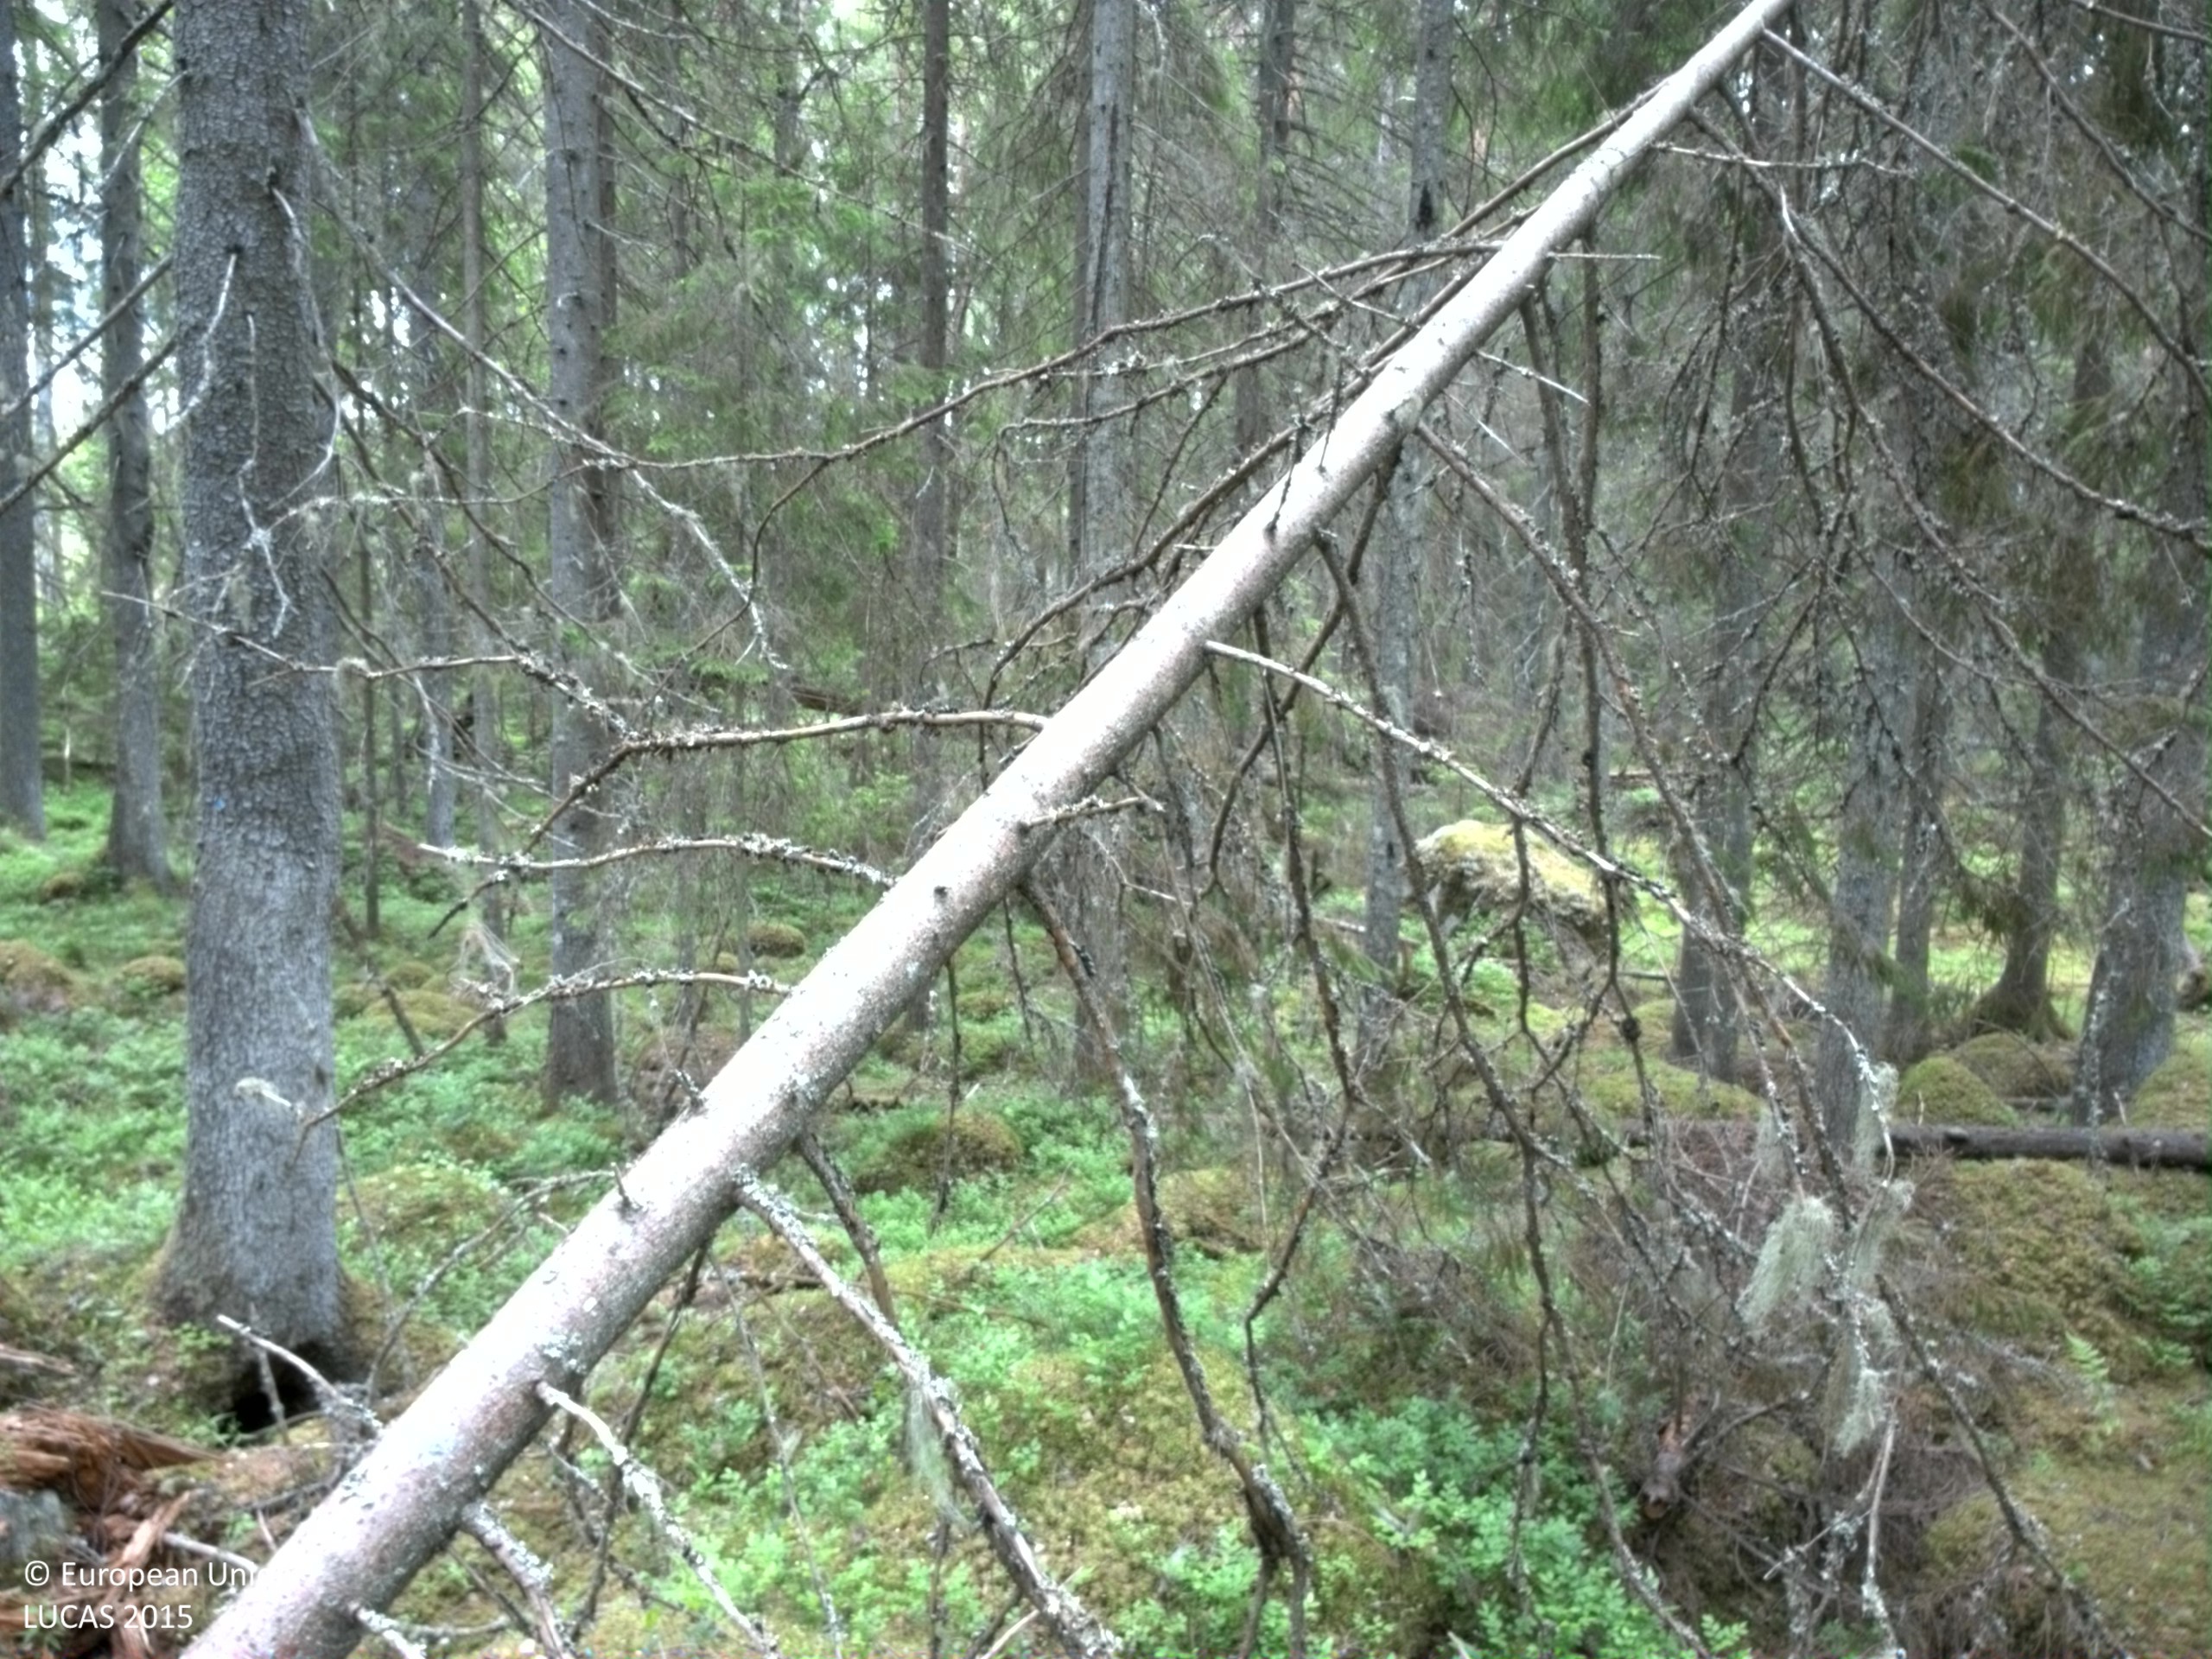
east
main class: Woodland
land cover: Spruce dominated coniferous woodland
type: boreal forest
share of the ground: > 75 %
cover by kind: coniferous forest trees 75 %, shrubs 10 %, lichens and mosses 10 %, broadleaved forest trees 5 %
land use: Forestry
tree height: > 5 m
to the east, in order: Spruce dominated coniferous woodland; Grassland with sparse tree/shrub cover; Other mixed woodland; Spruce dominated mixed woodland
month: June
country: SE
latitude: 60.3109
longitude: 17.7577
